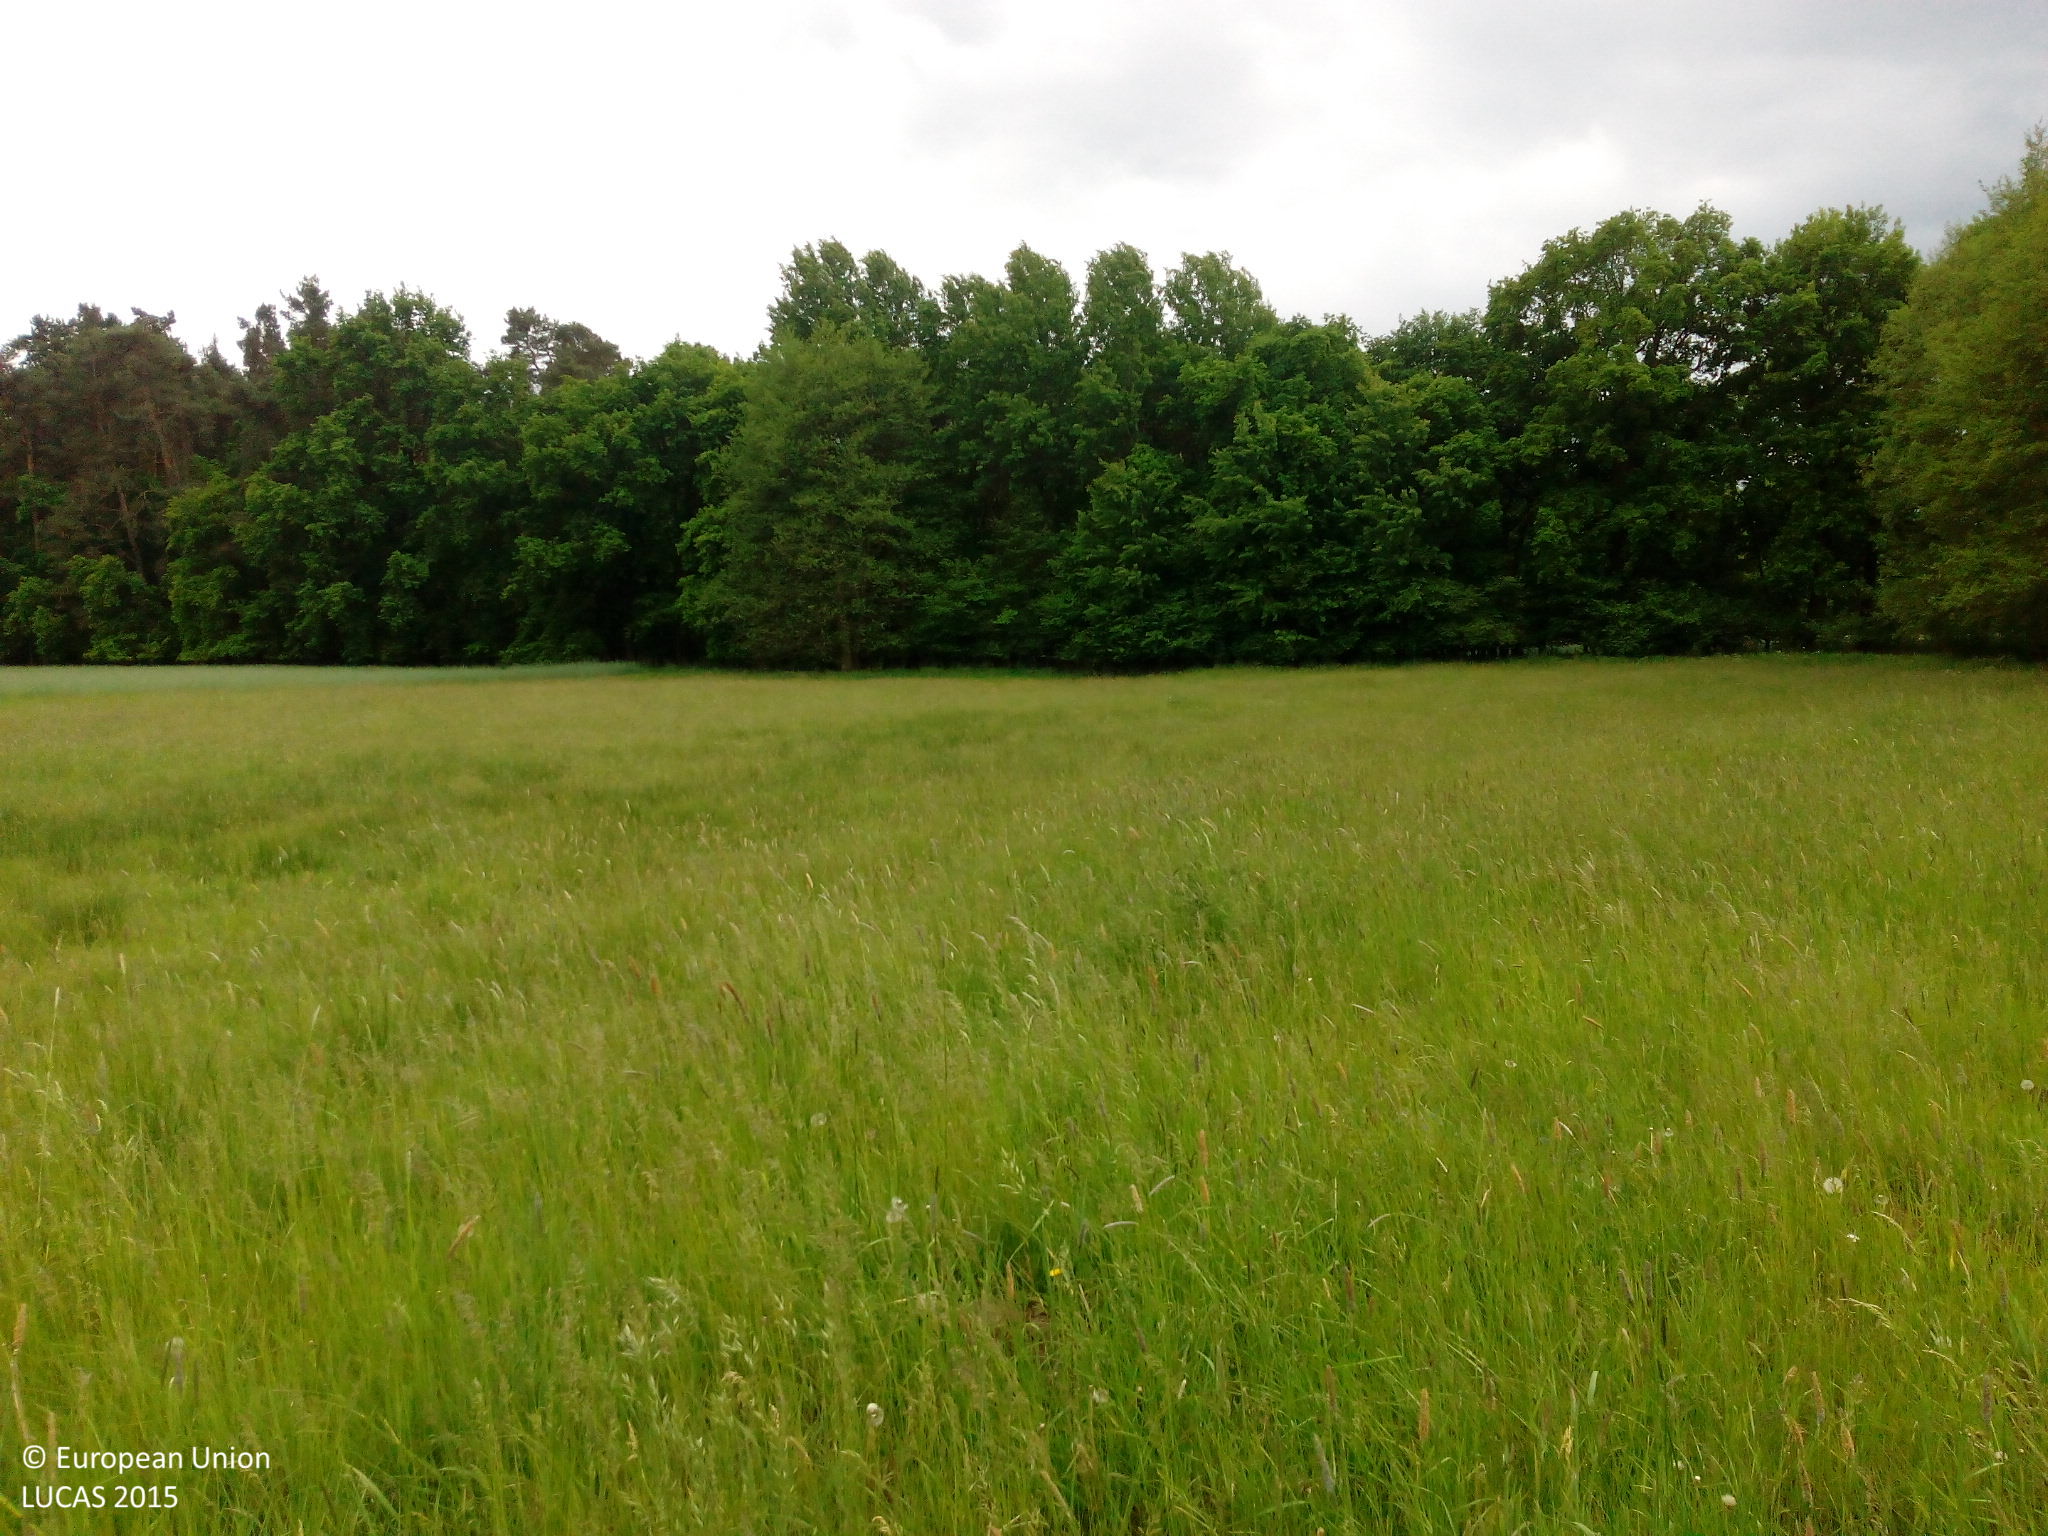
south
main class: Grassland
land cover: Grassland without tree/shrub cover
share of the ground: > 75 %
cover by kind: herbaceous plants 100 %
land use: Agriculture (excluding fallow land and kitchen gardens)
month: May
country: DE
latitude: 51.7687
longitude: 14.0440
